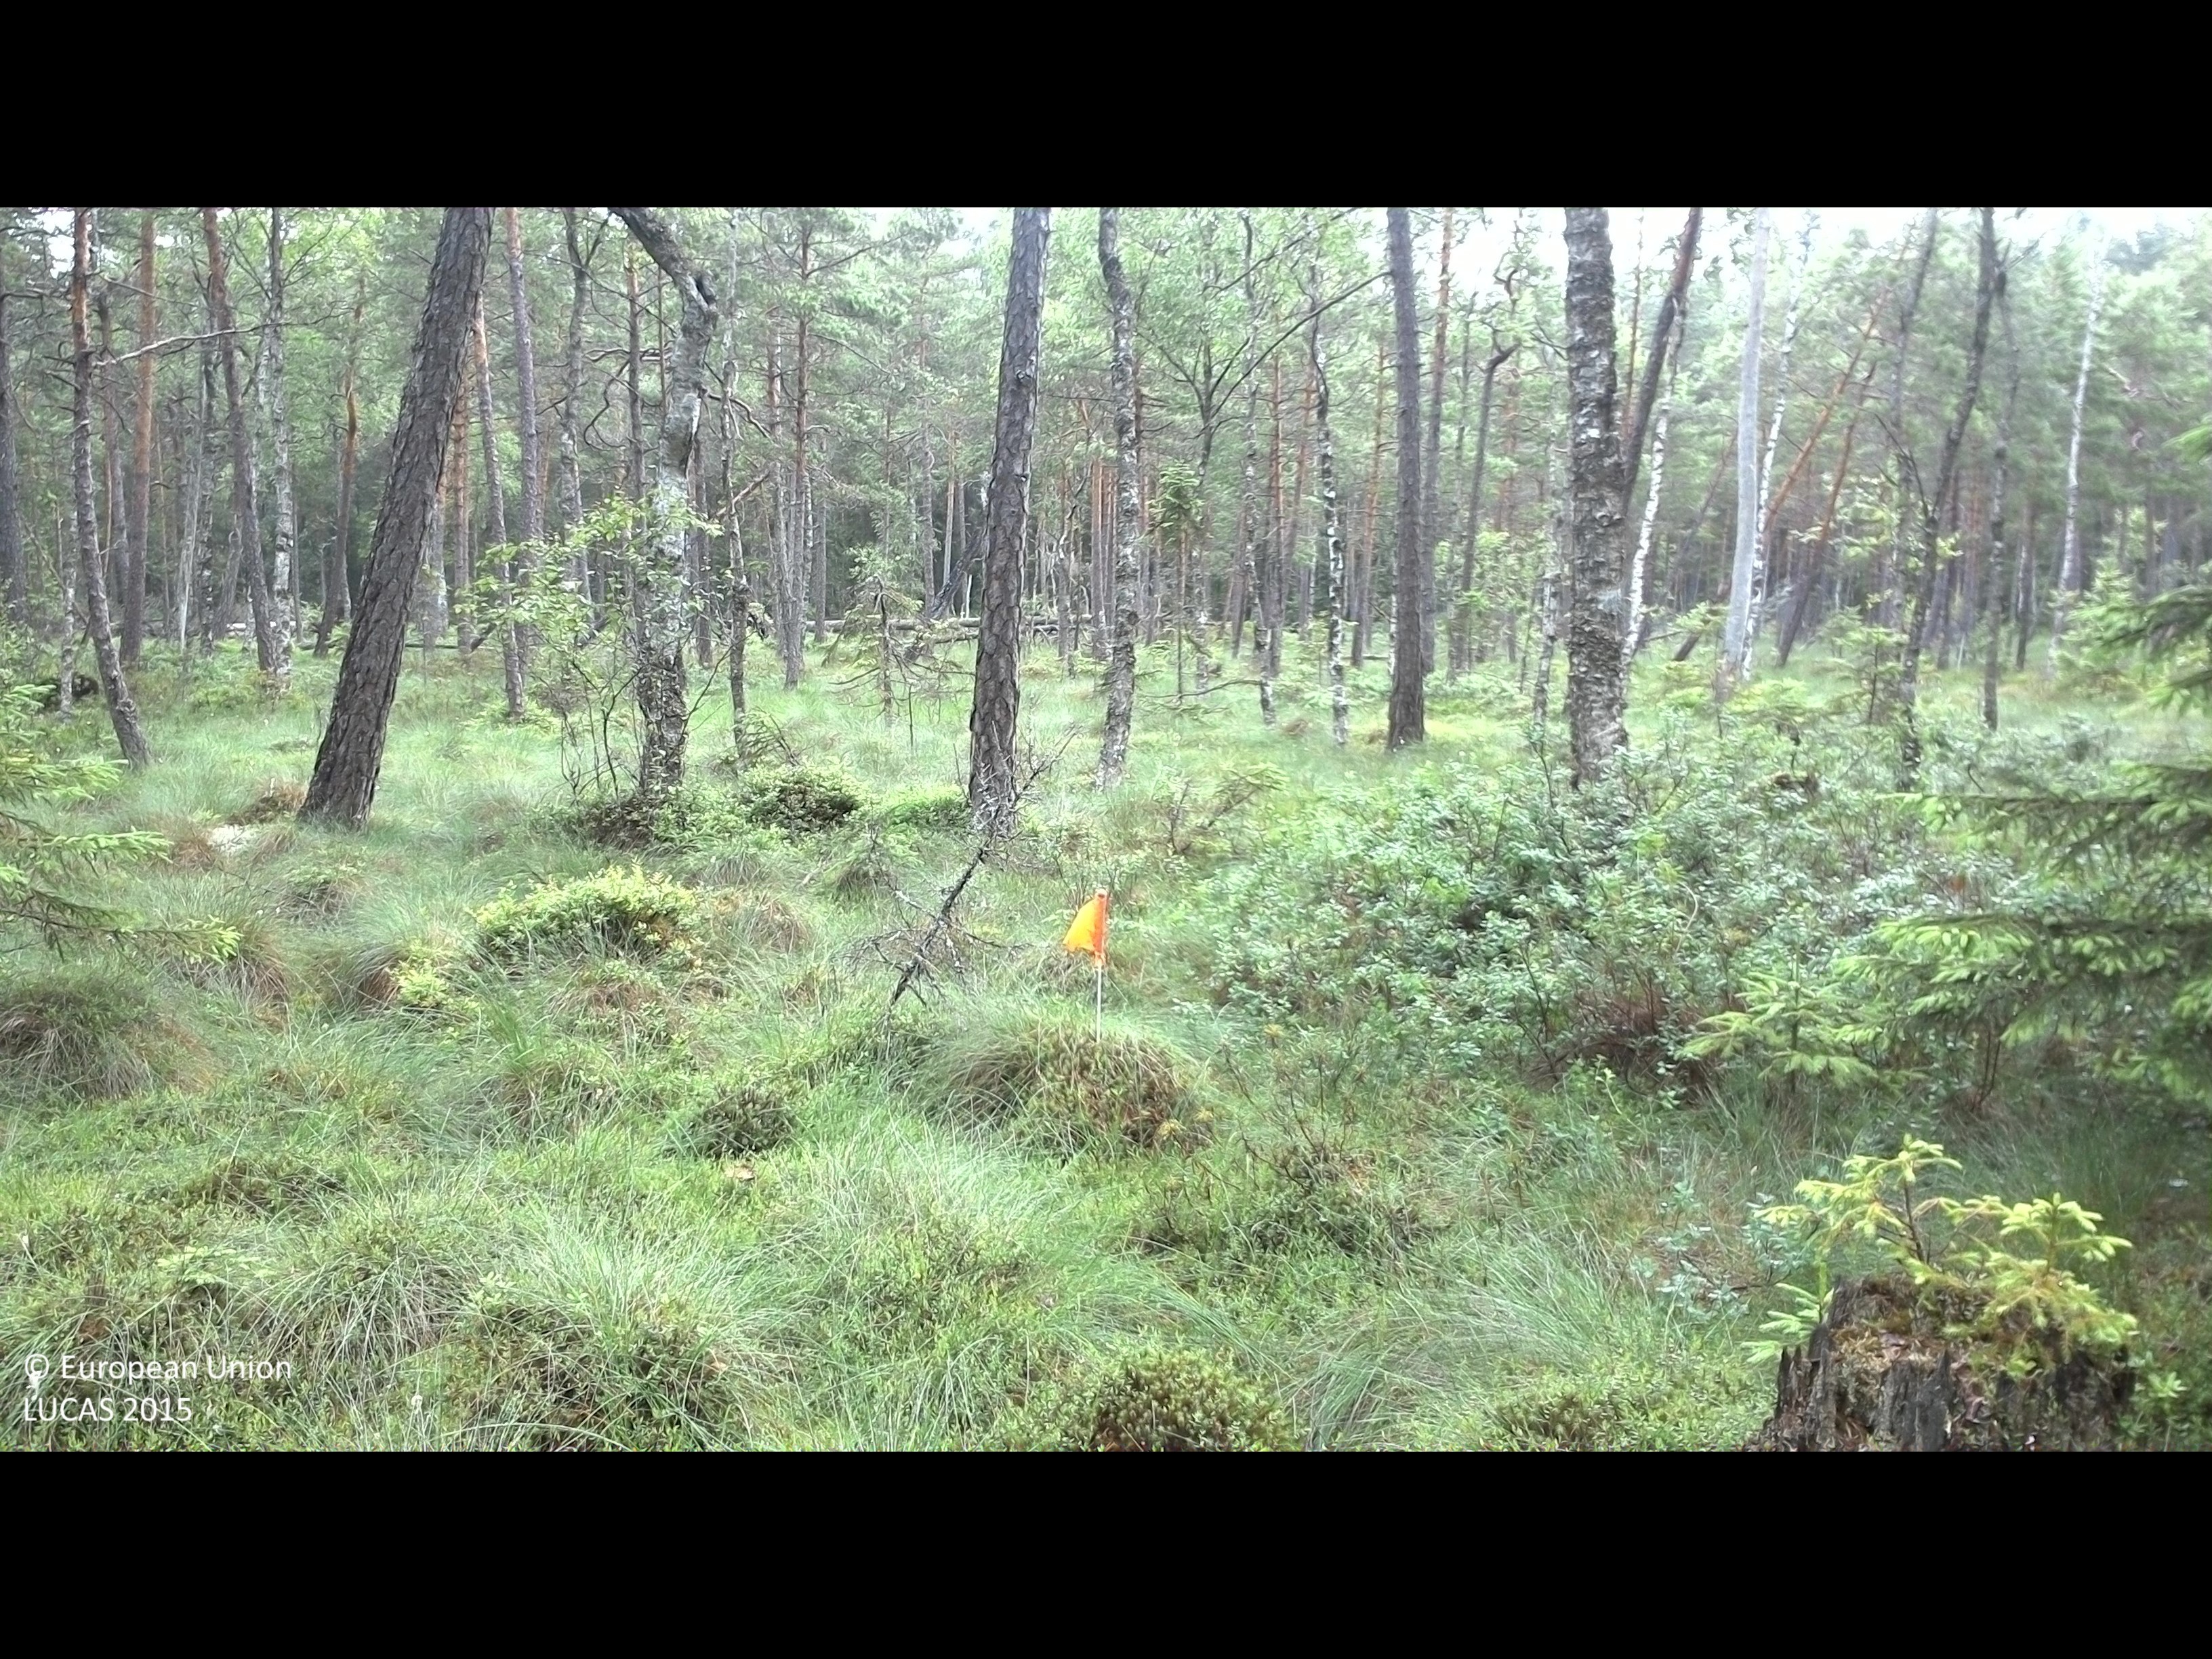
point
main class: Woodland
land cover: Pine dominated mixed woodland
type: boreal forest
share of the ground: 25 - 50 %
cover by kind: coniferous forest trees 35 %, shrubs 25 %, lichens and mosses 20 %, broadleaved forest trees 15 %, herbaceous plants 5 %
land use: Forestry
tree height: > 5 m
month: July
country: SE
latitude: 56.5376
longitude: 14.5995
